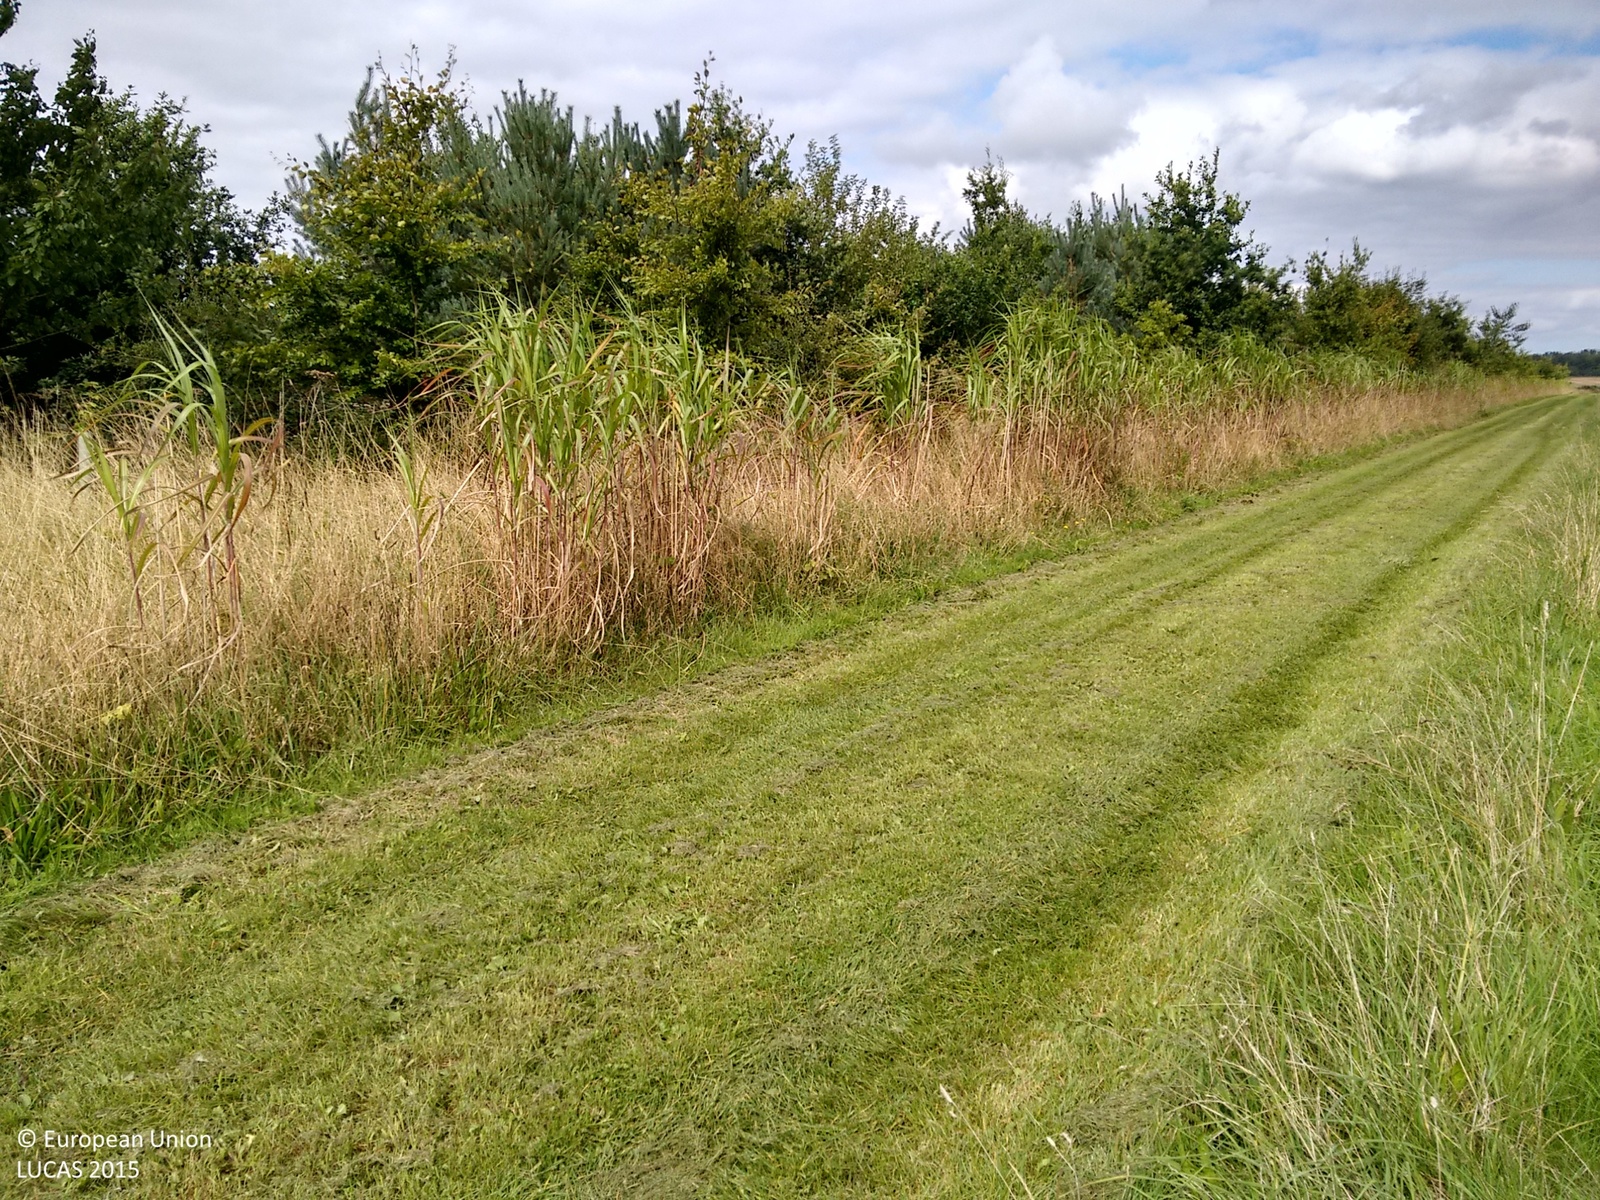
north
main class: Cropland
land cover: Common wheat
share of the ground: > 75 %
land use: Agriculture (excluding fallow land and kitchen gardens)
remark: Harvested field
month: September
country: GB
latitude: 52.6170
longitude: 0.8031
